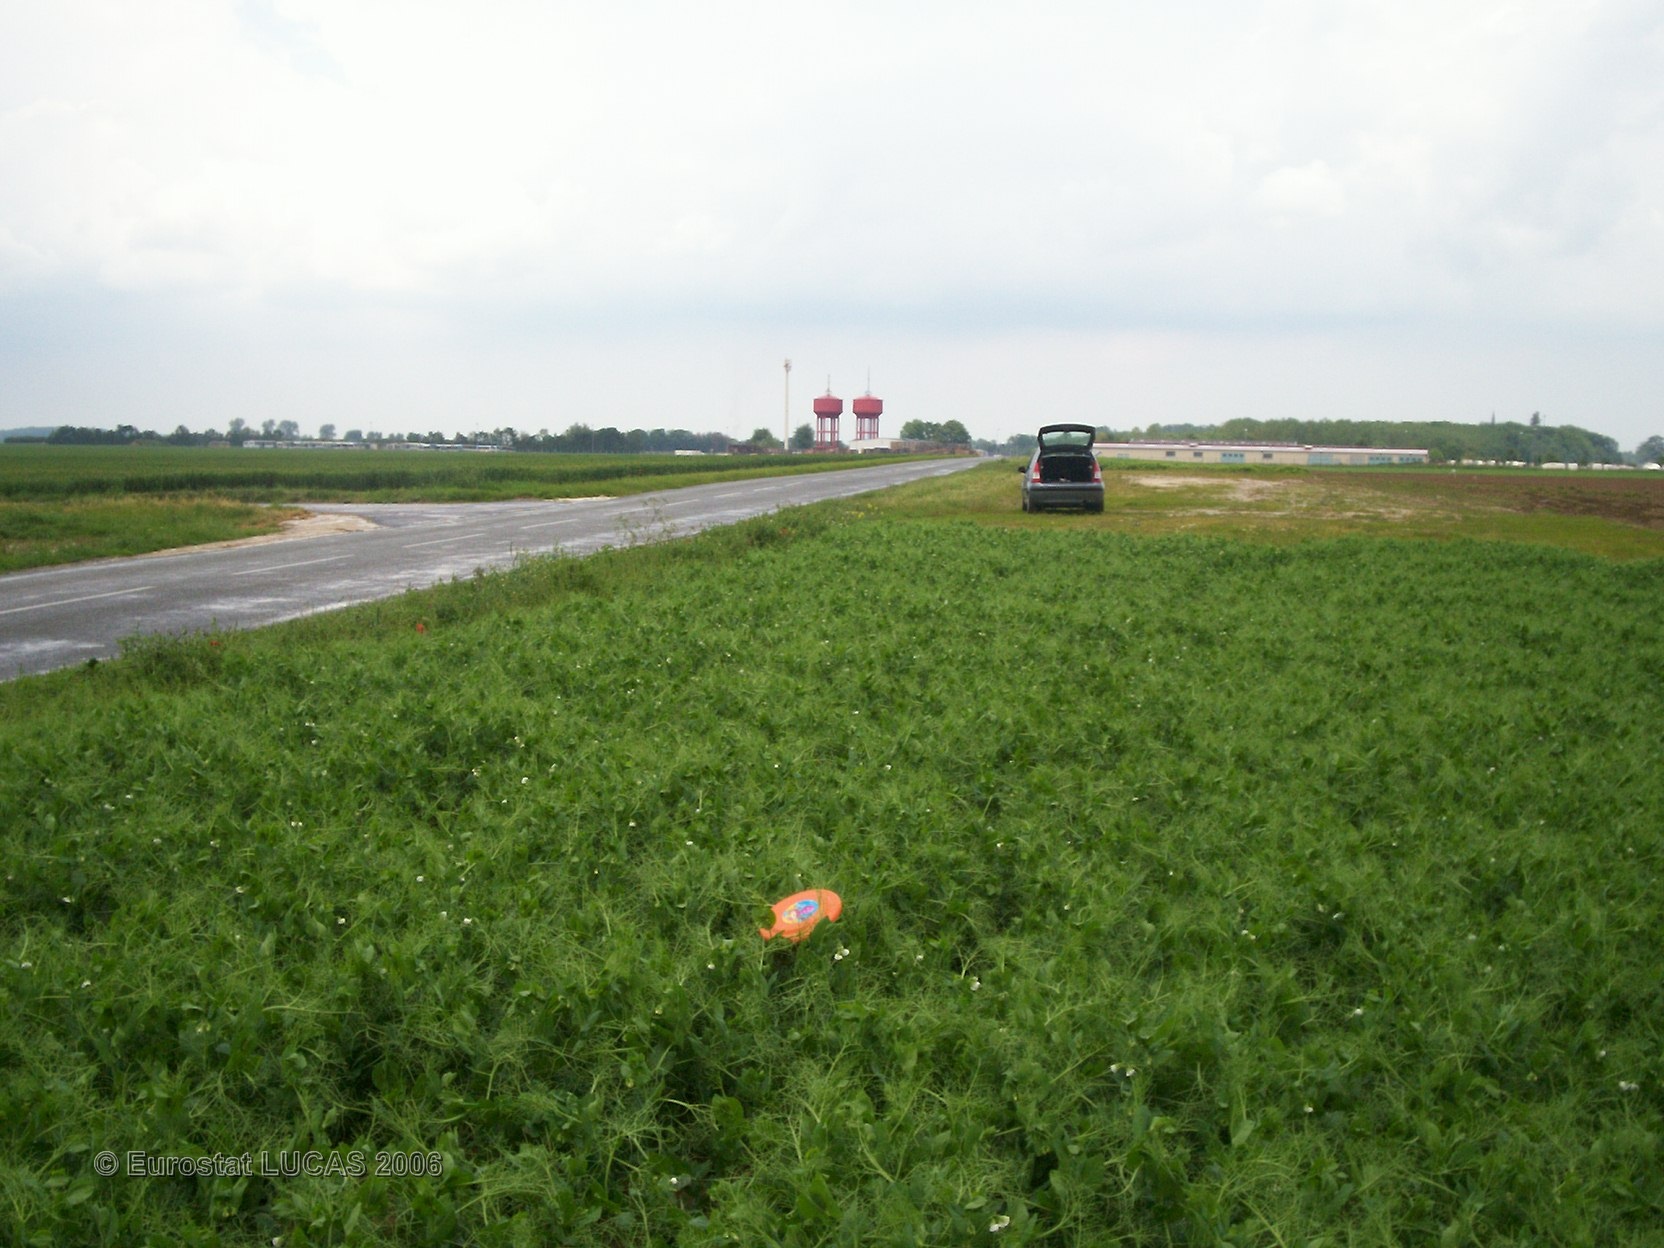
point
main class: Cropland
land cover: Dry pulses
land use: Agriculture (excluding fallow land and kitchen gardens)
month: June
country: FR
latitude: 49.7641
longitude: 2.6165
